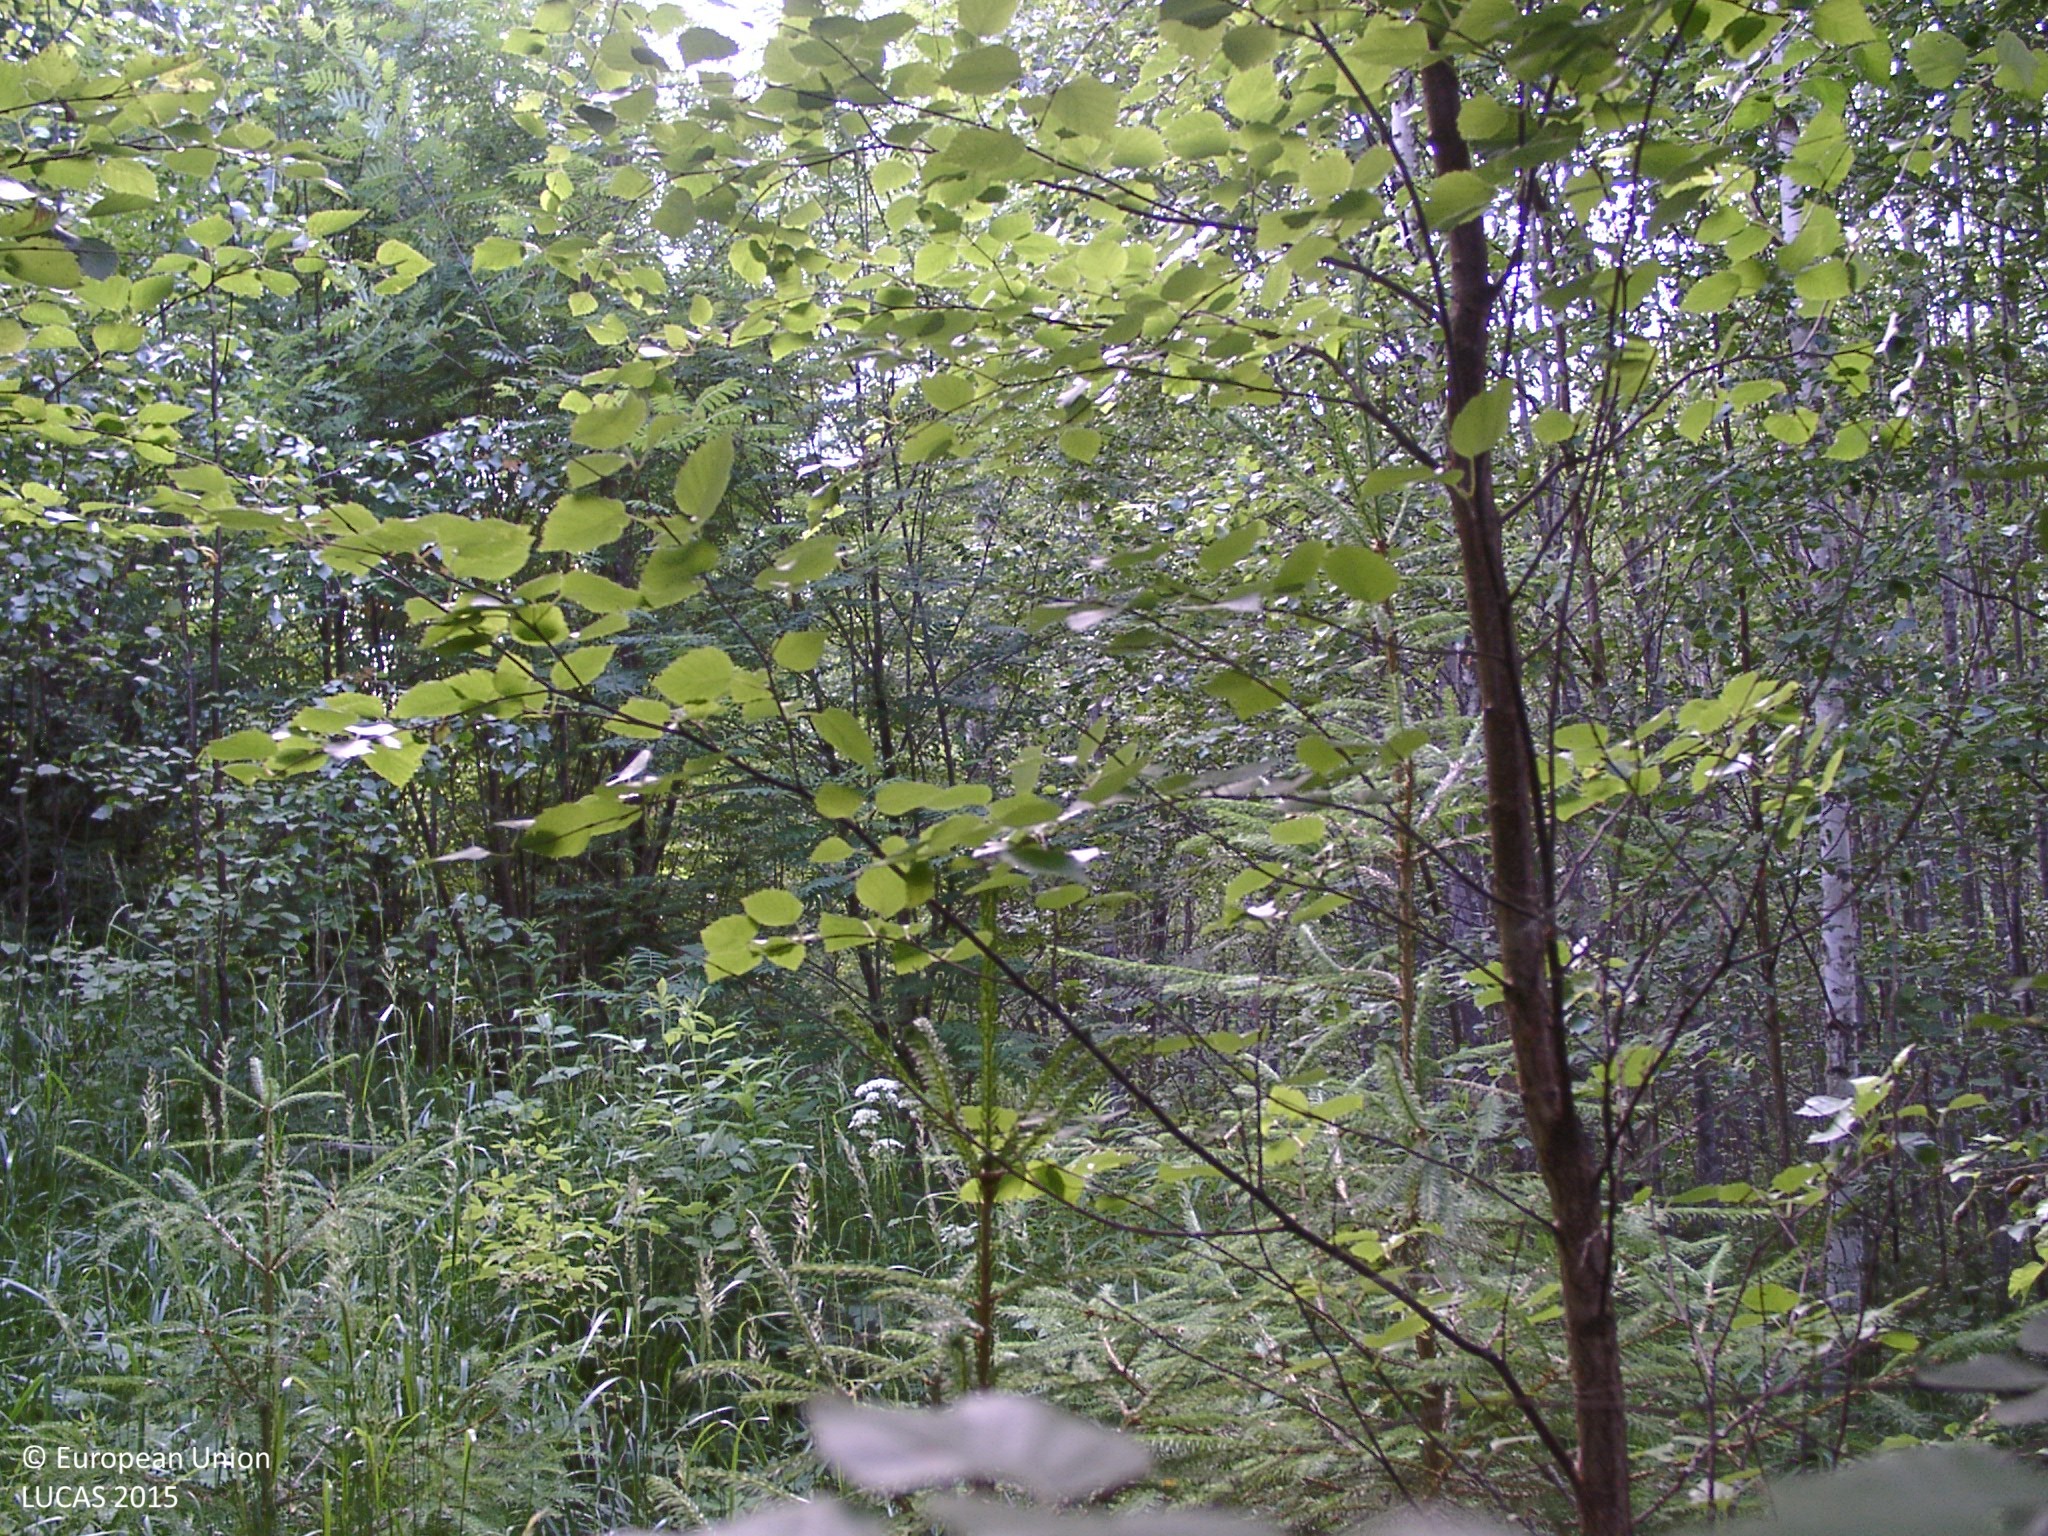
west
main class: Woodland
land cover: Broadleaved woodland
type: non-riverine alder, birch or aspen forest
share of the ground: > 75 %
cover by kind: broadleaved forest trees 75 %, herbaceous plants 20 %, shrubs 5 %
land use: Semi-natural and natural areas not in use
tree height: > 5 m
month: July
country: FI
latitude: 61.6112
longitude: 25.2155
